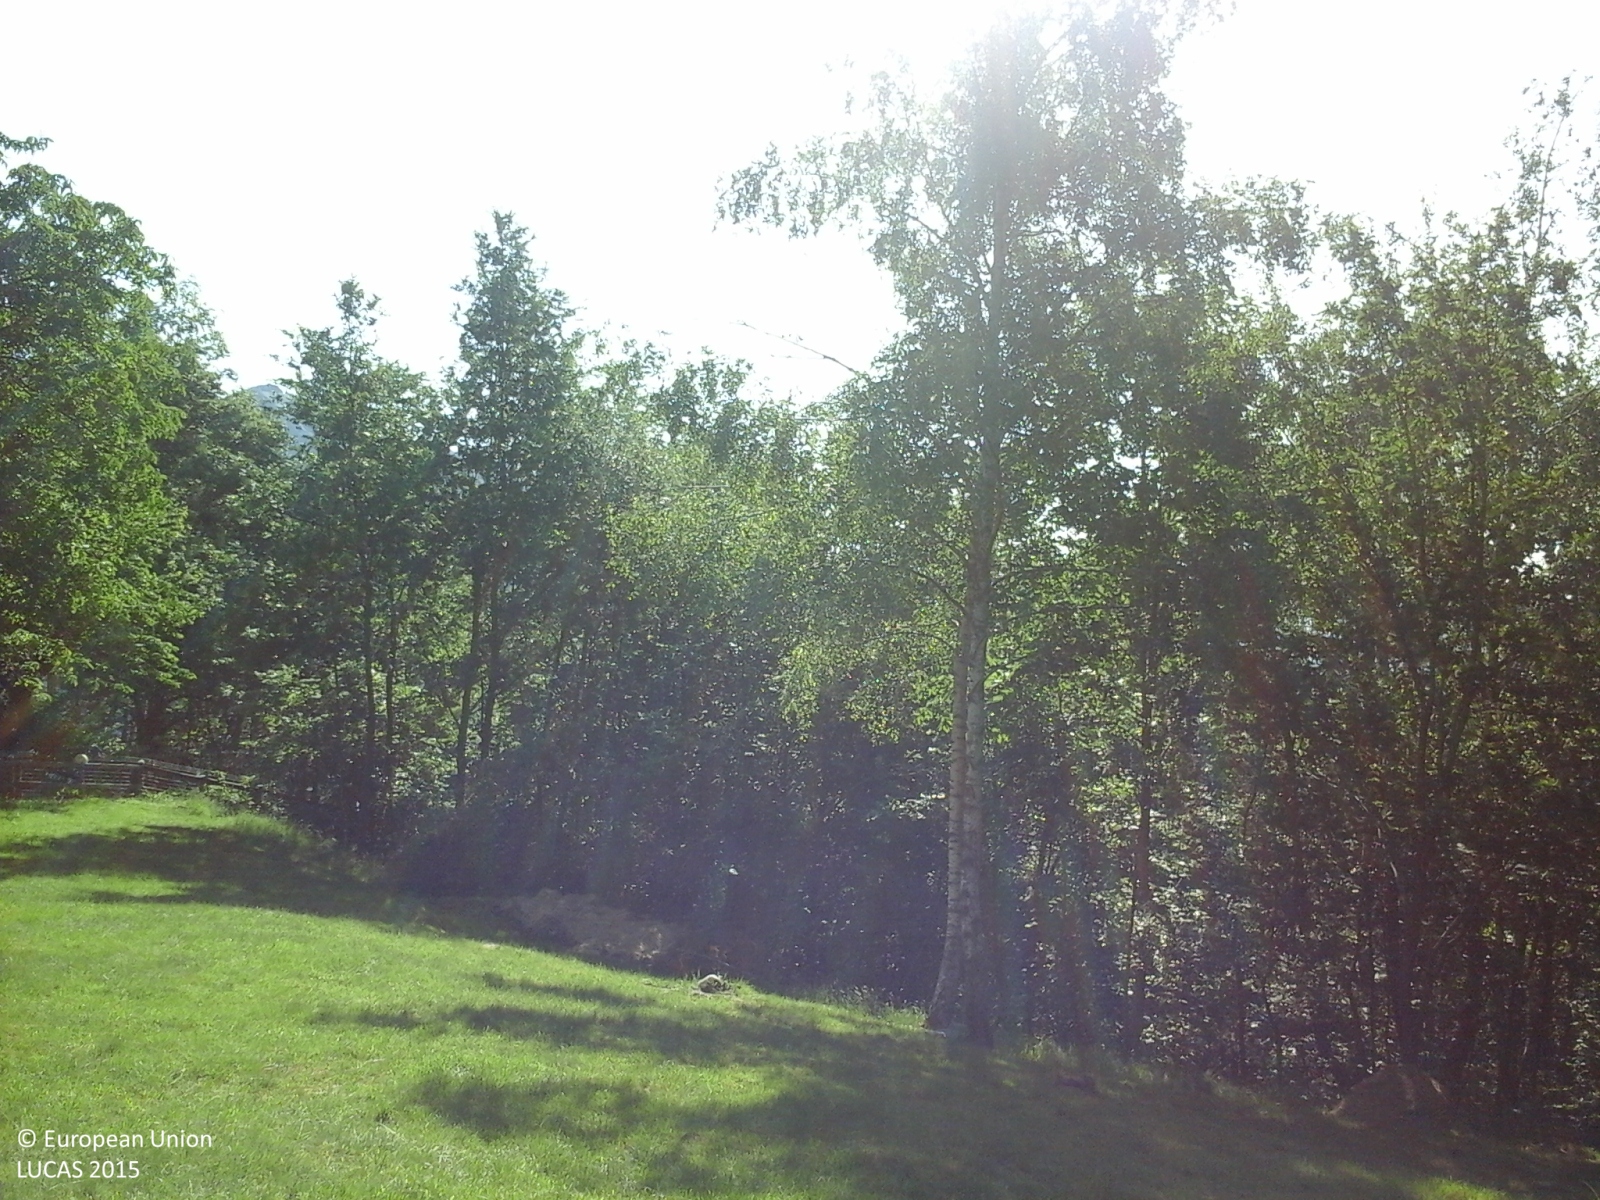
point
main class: Woodland
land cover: Broadleaved woodland
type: mesophytic deciduous forest
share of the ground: > 75 %
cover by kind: broadleaved forest trees 100 %
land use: Forestry
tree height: > 5 m
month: June
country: IT
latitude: 45.9799
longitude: 8.4662
